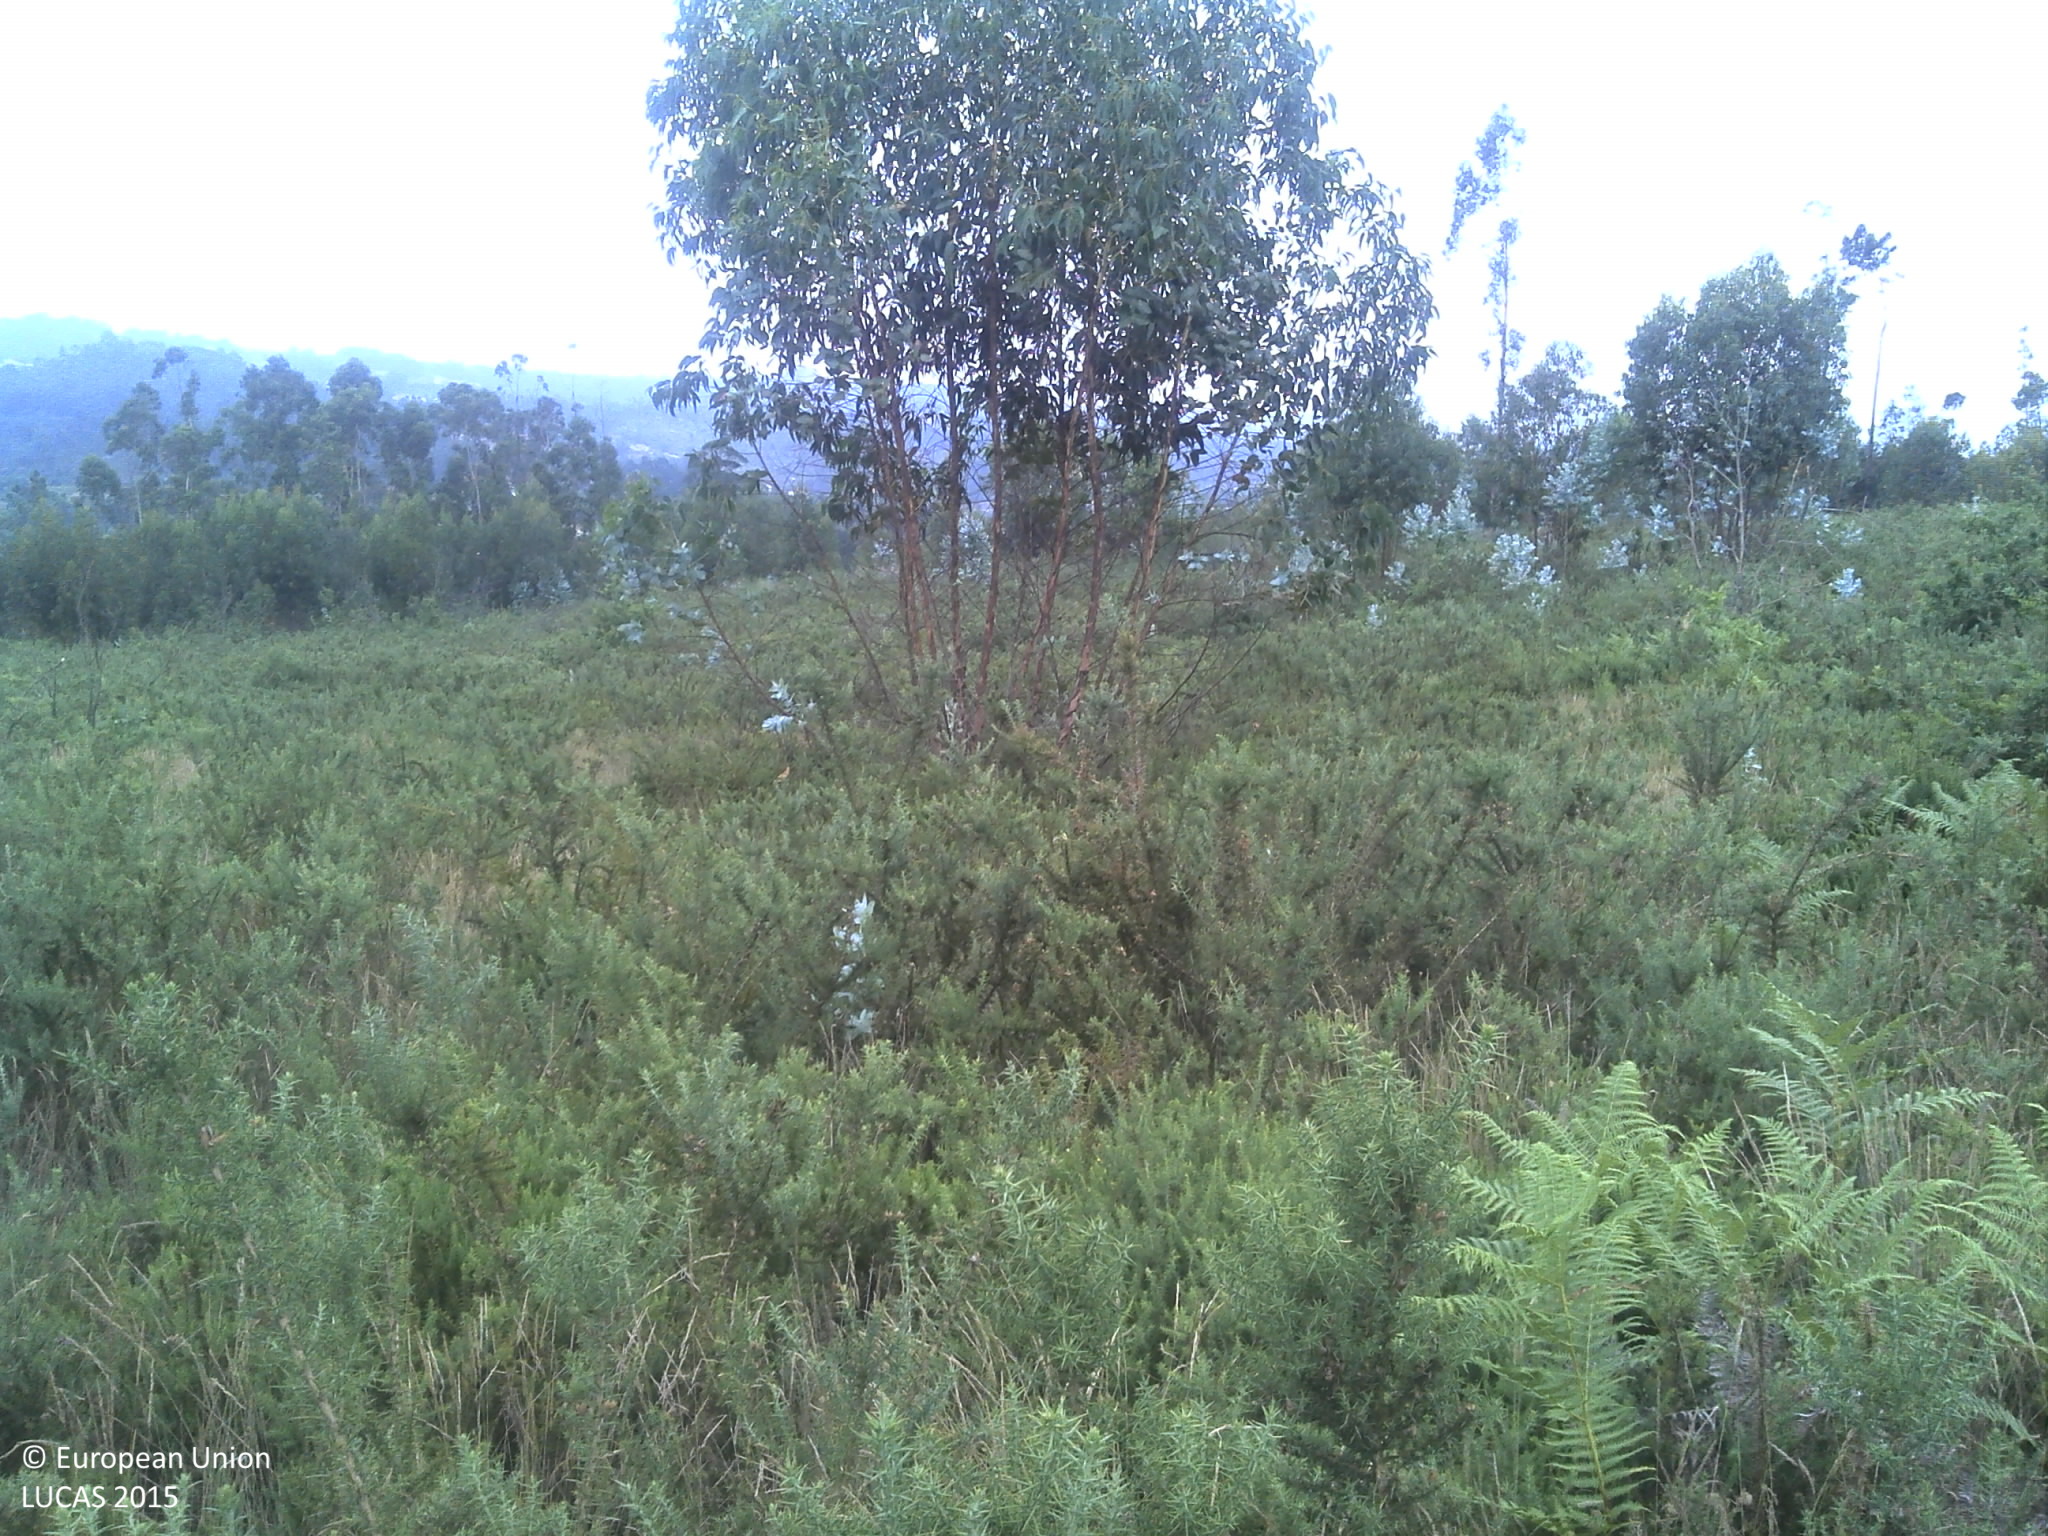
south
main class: Shrubland
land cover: Shrubland with sparse tree cover
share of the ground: 50 - 75 %
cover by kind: shrubs 75 %, herbaceous plants 15 %, broadleaved forest trees 5 %, unconsolidated bare surface 5 %
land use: Forestry
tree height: > 5 m
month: June
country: PT
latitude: 41.2521
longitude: -8.2723
